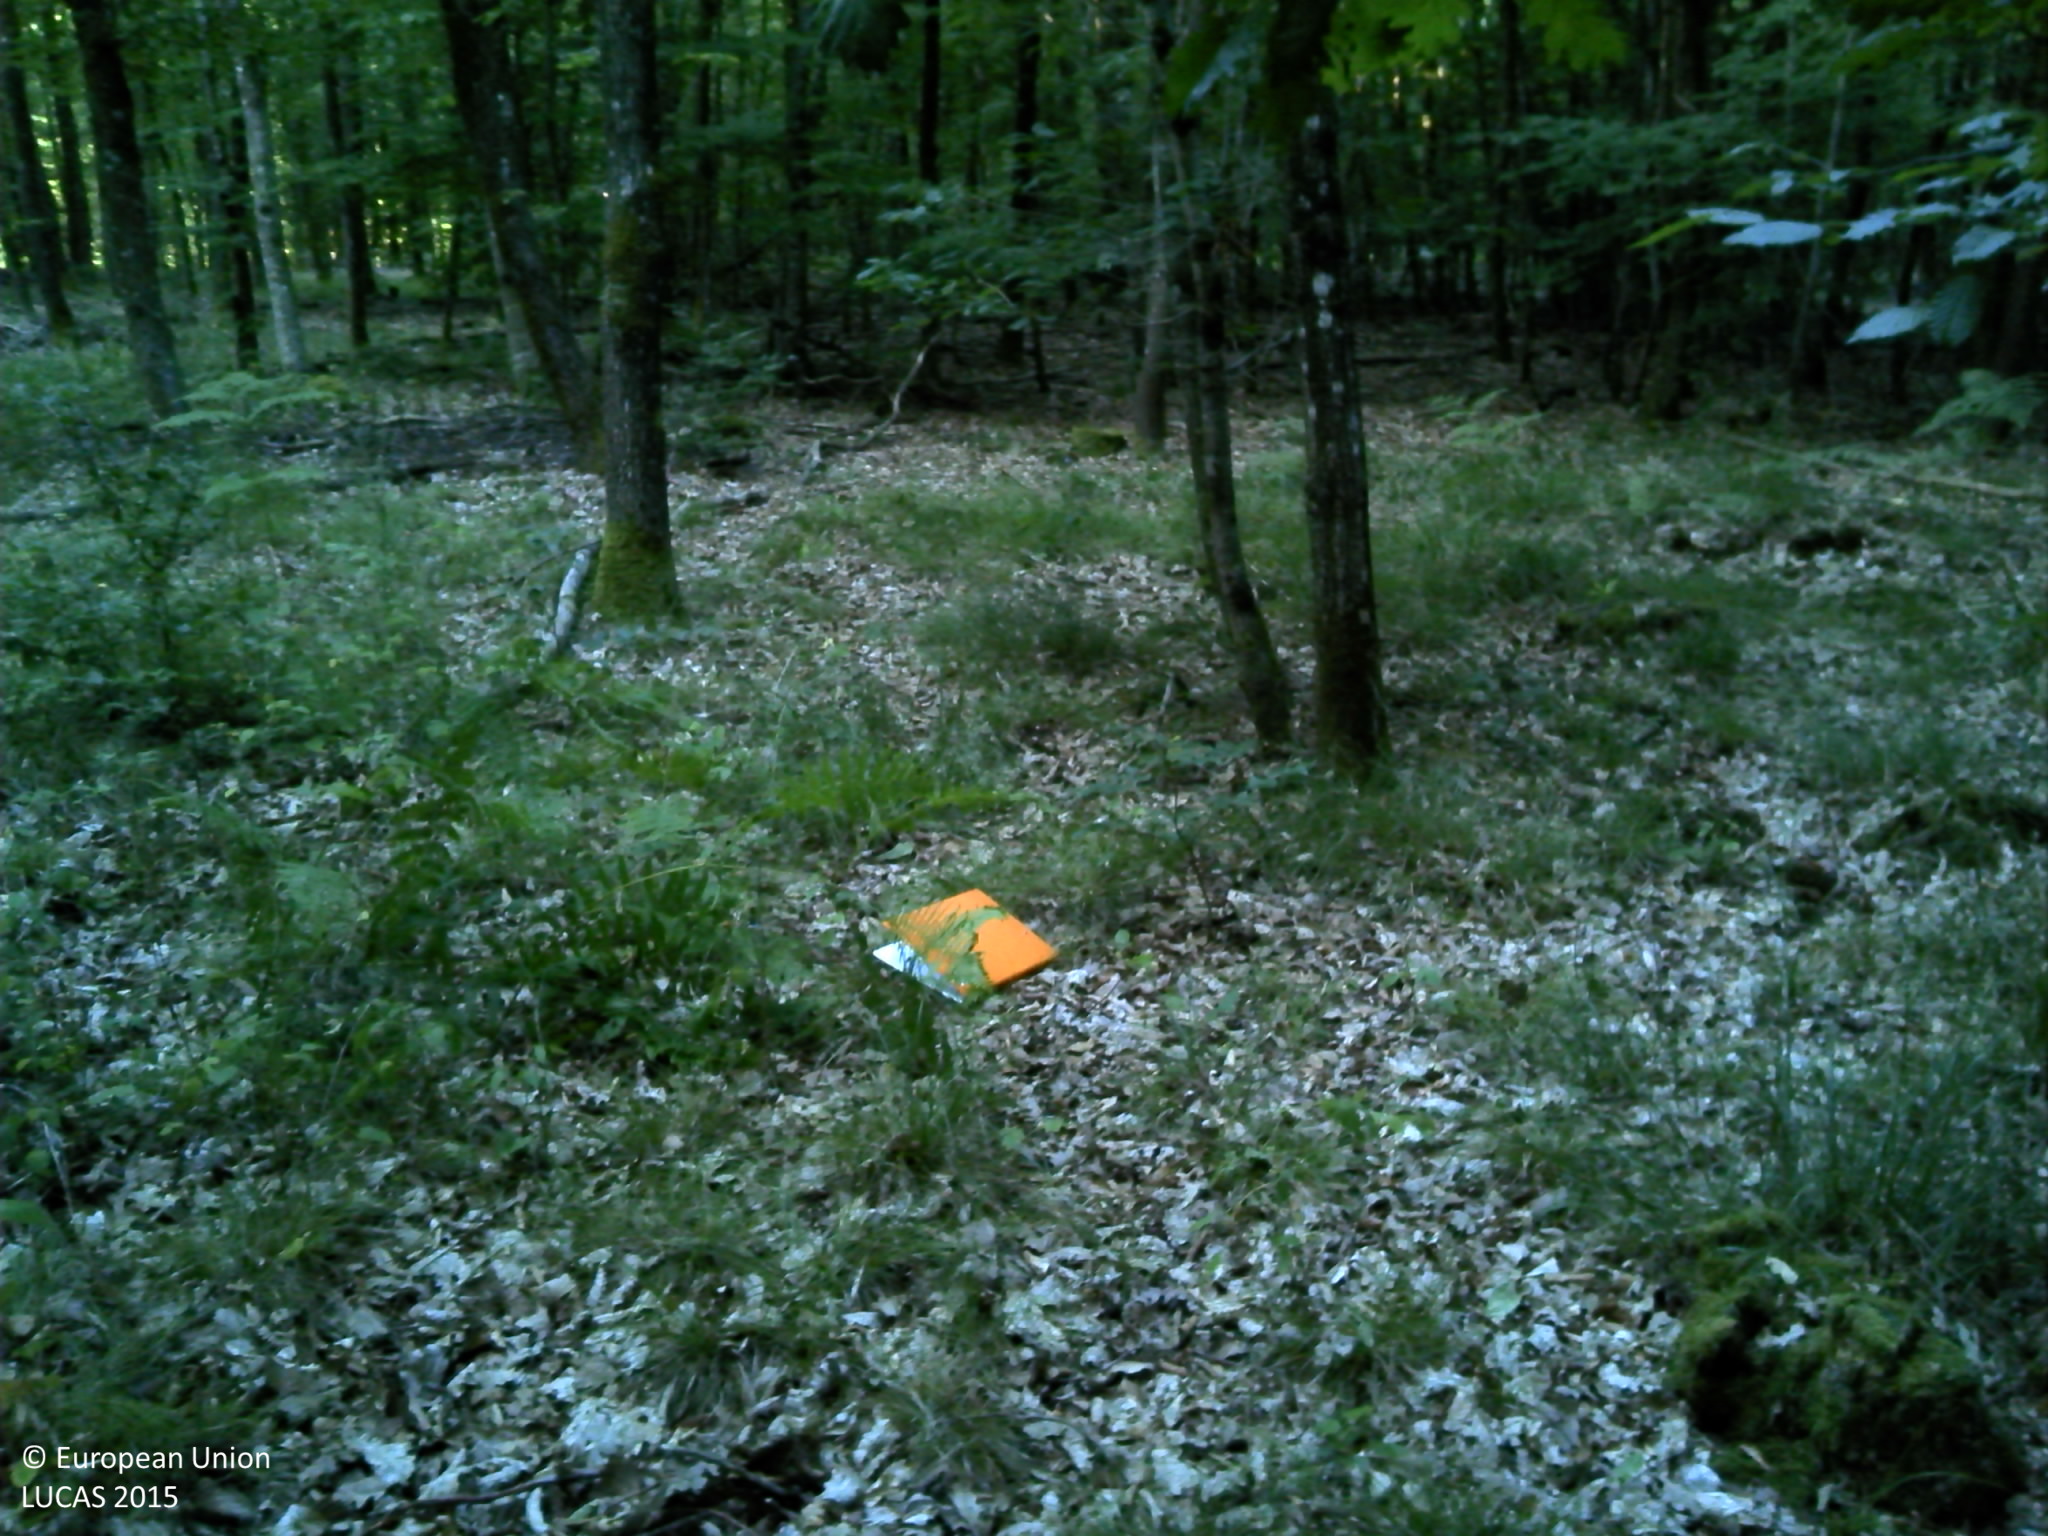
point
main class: Woodland
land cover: Broadleaved woodland
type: acidophilous oak and oak-birch forest
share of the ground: > 75 %
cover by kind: broadleaved forest trees 100 %
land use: Forestry
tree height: > 5 m
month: July
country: FR
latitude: 48.3961
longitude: 6.3132
